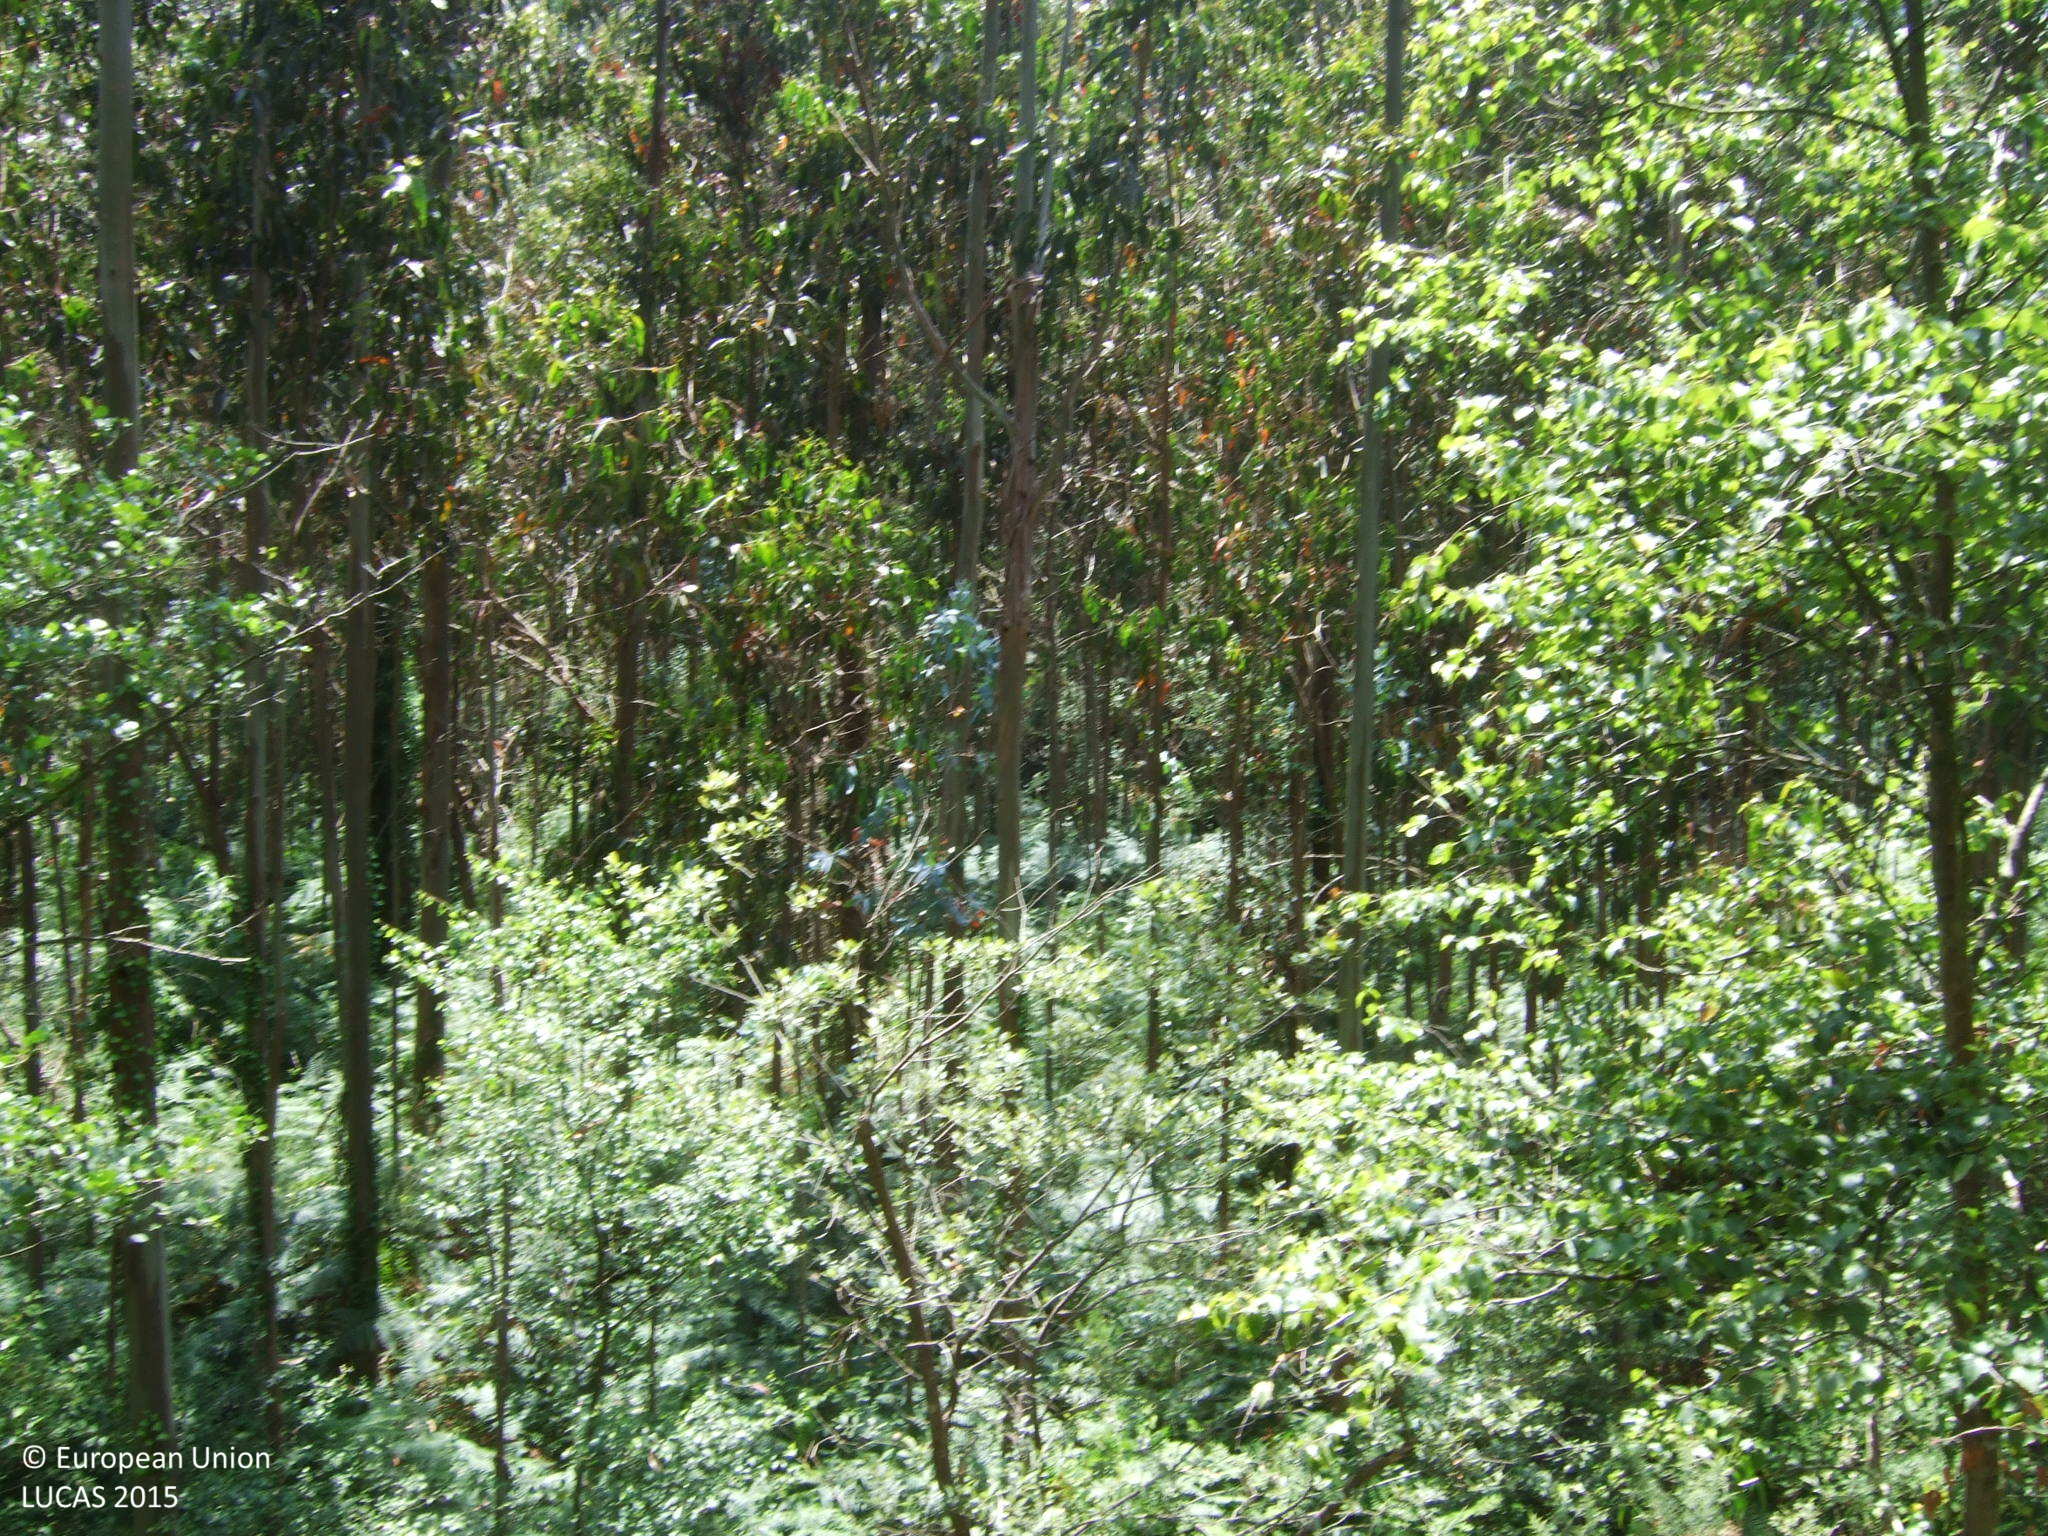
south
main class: Woodland
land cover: Broadleaved woodland
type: exotic forest
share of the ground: 25 - 50 %
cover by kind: shrubs 65 %, broadleaved forest trees 35 %
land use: Forestry
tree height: > 5 m
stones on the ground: < 10 %
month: June
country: ES
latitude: 43.6314
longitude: -7.3441
